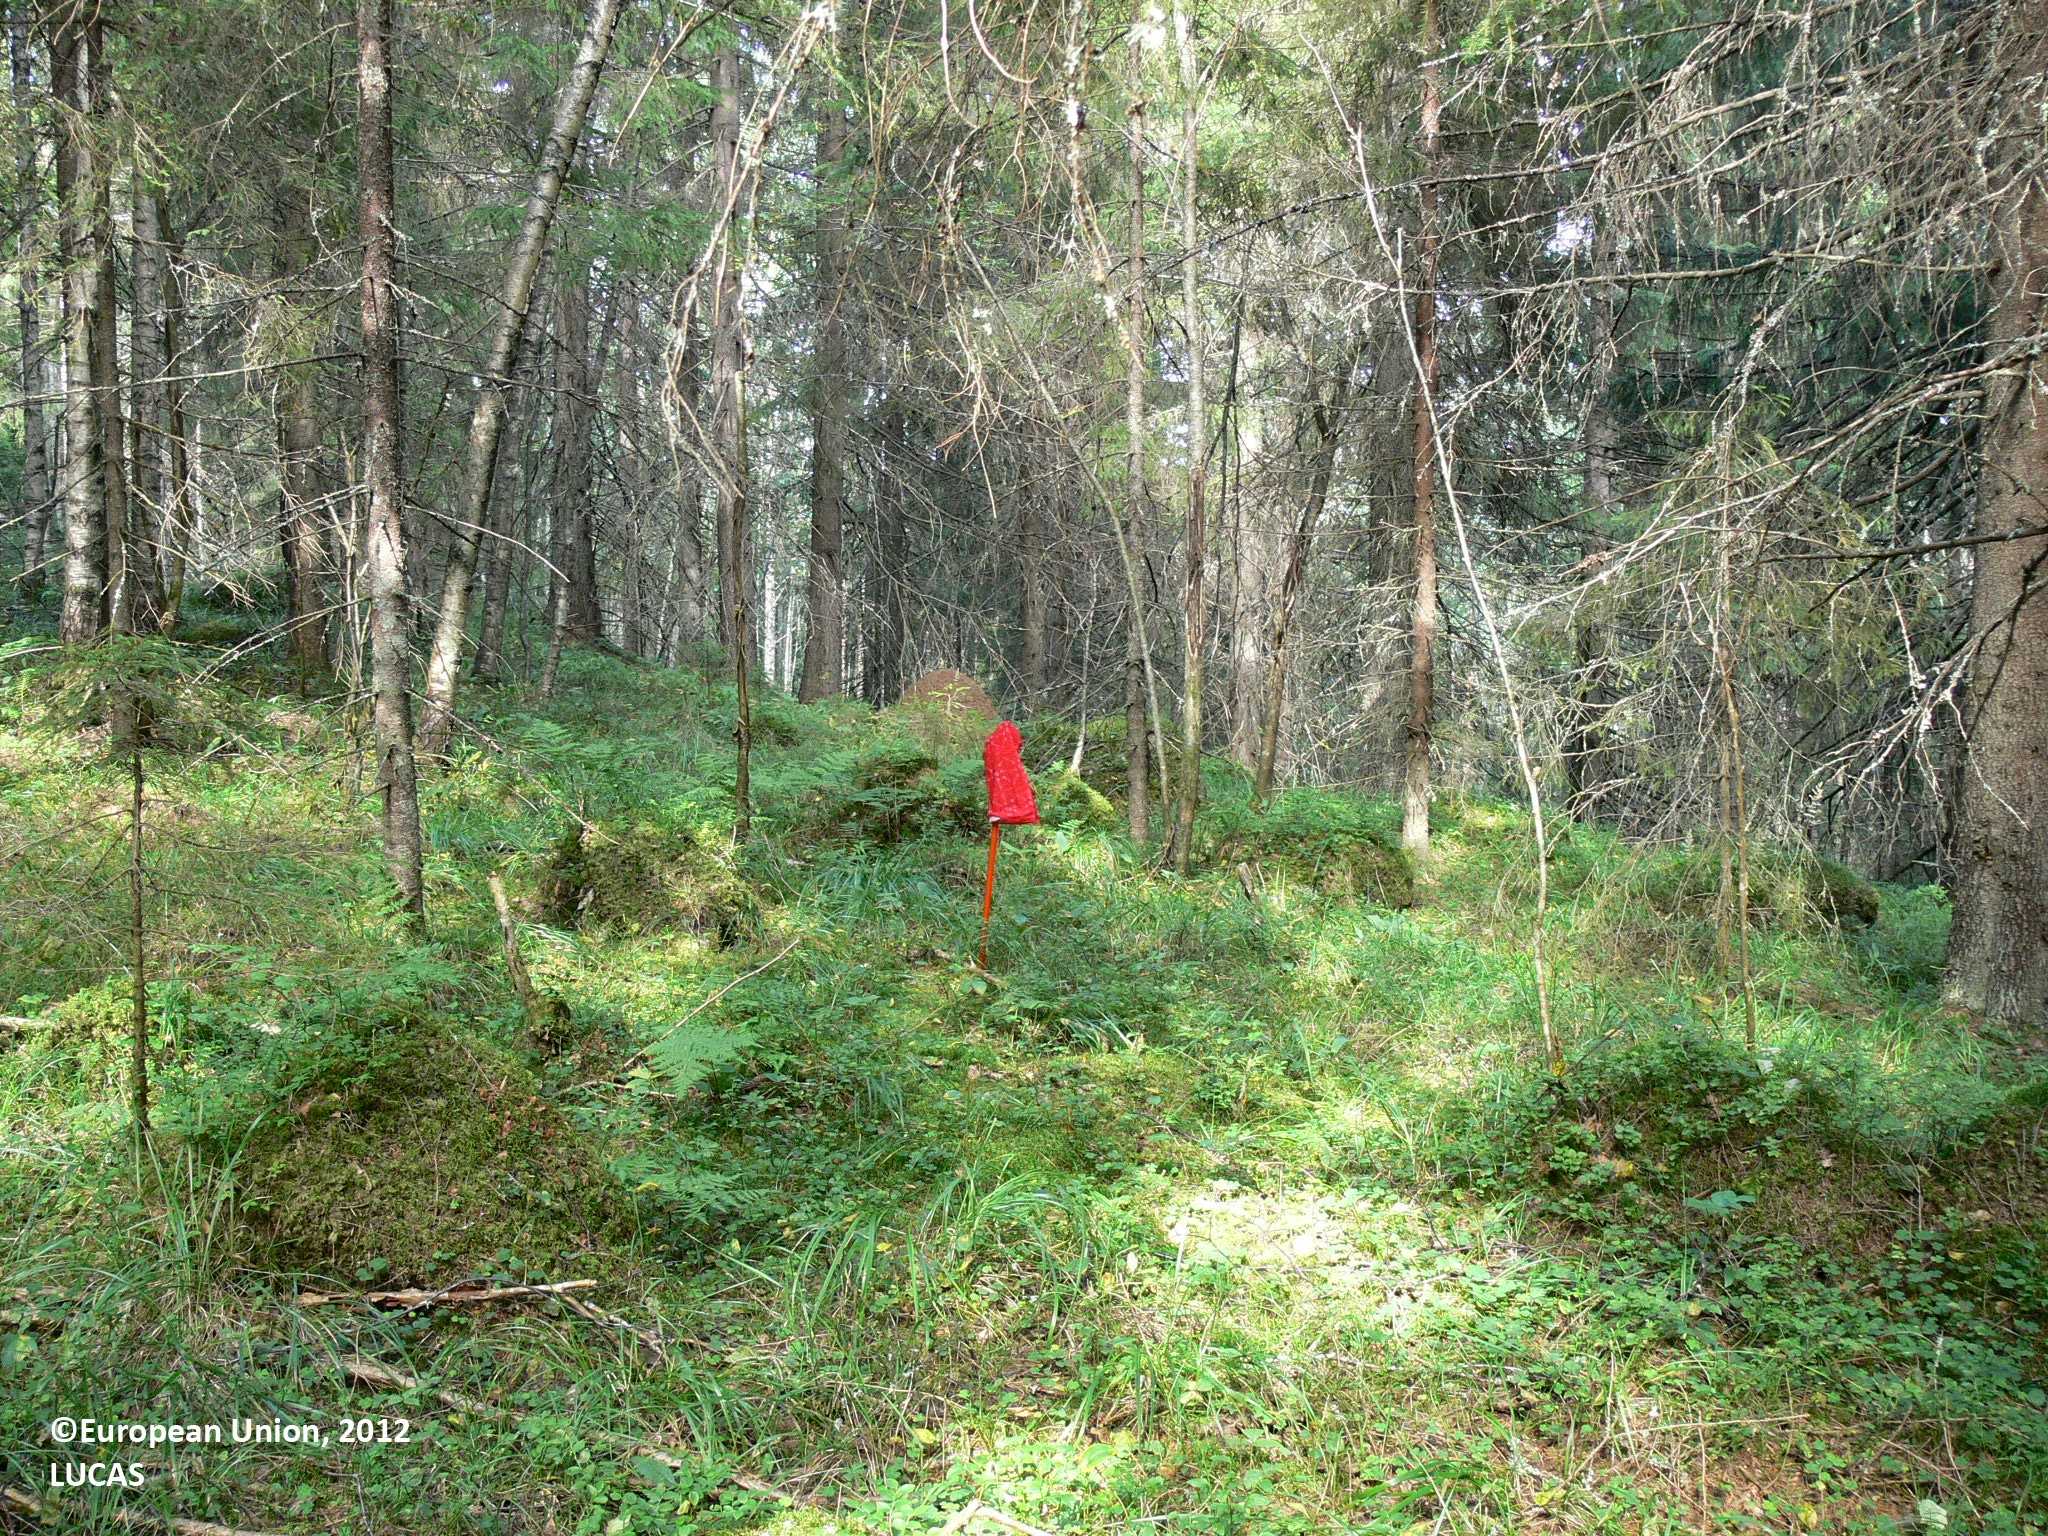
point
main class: Woodland
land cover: Spruce dominated mixed woodland
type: boreal forest
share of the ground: > 75 %
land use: Semi-natural and natural areas not in use
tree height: > 5 m
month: August
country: FI
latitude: 63.0866
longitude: 29.8305
